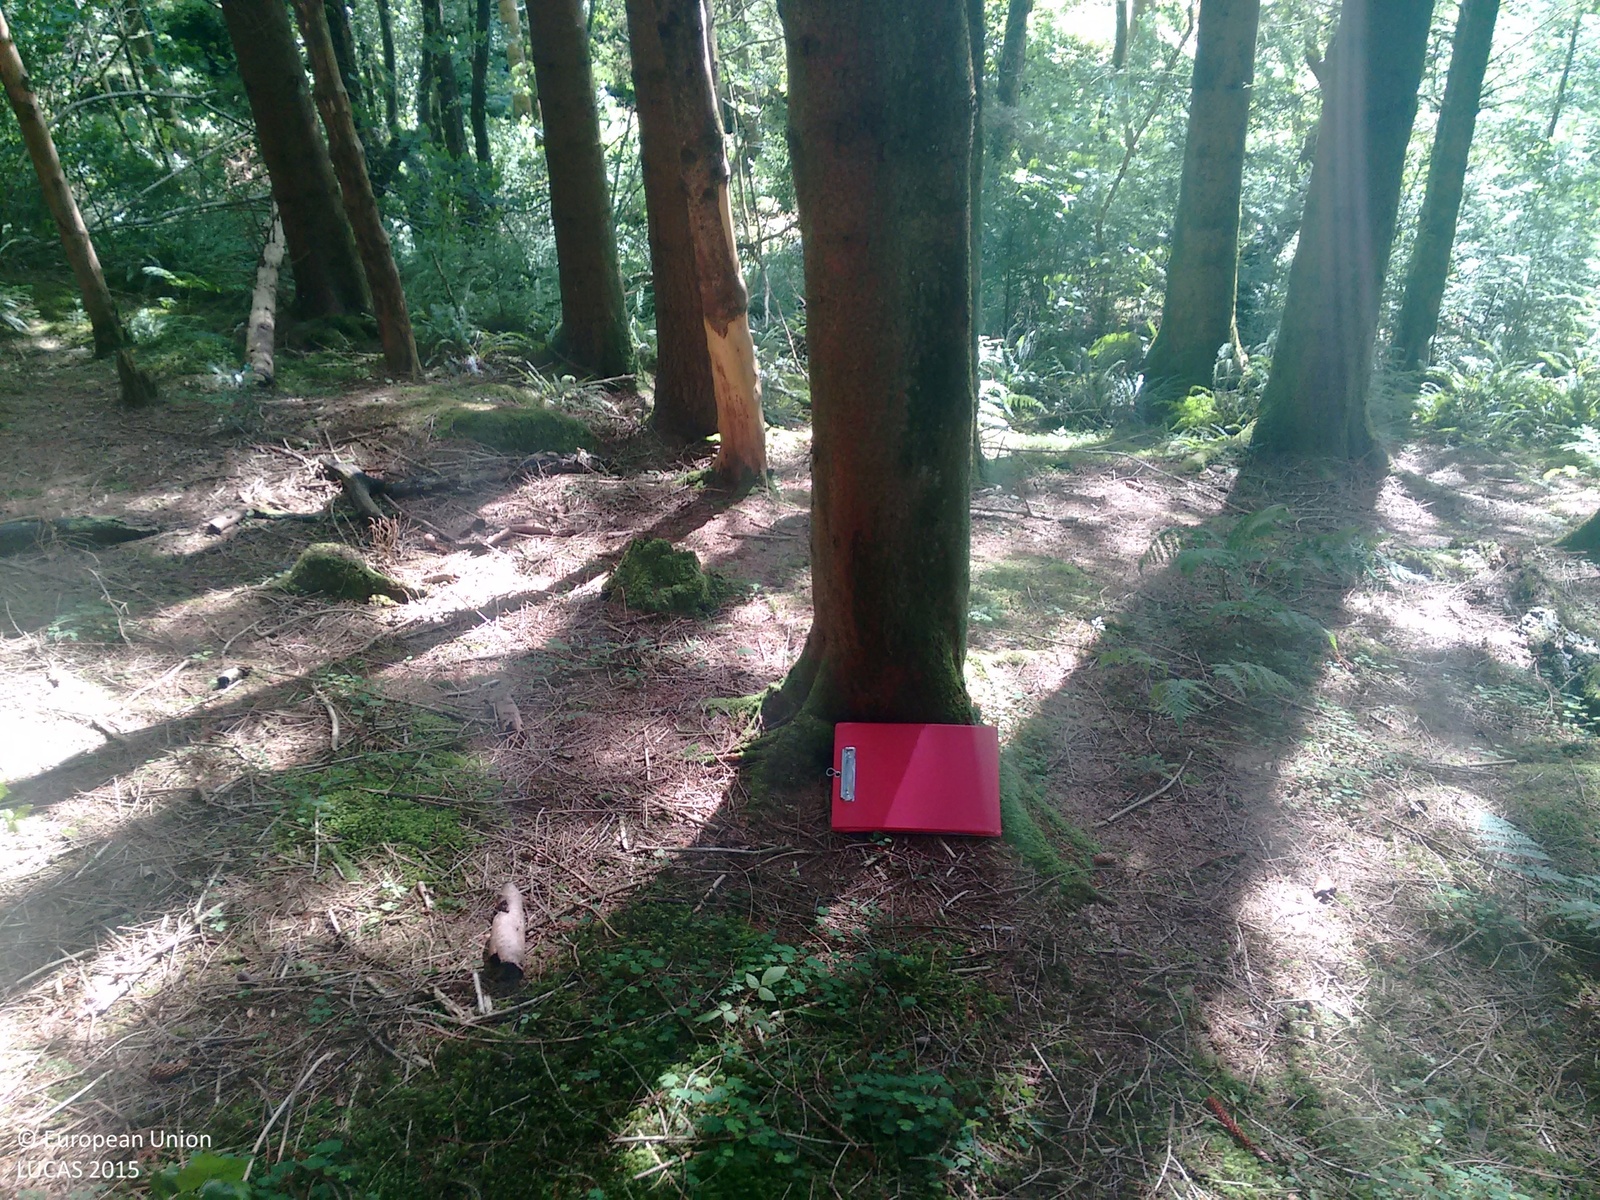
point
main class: Woodland
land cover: Pine dominated coniferous woodland
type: exotic forest
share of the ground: > 75 %
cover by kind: coniferous forest trees 90 %, broadleaved forest trees 10 %
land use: Forestry
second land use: Amenities, museums, leisure
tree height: > 5 m
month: July
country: GB
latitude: 55.5194
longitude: -5.1460
